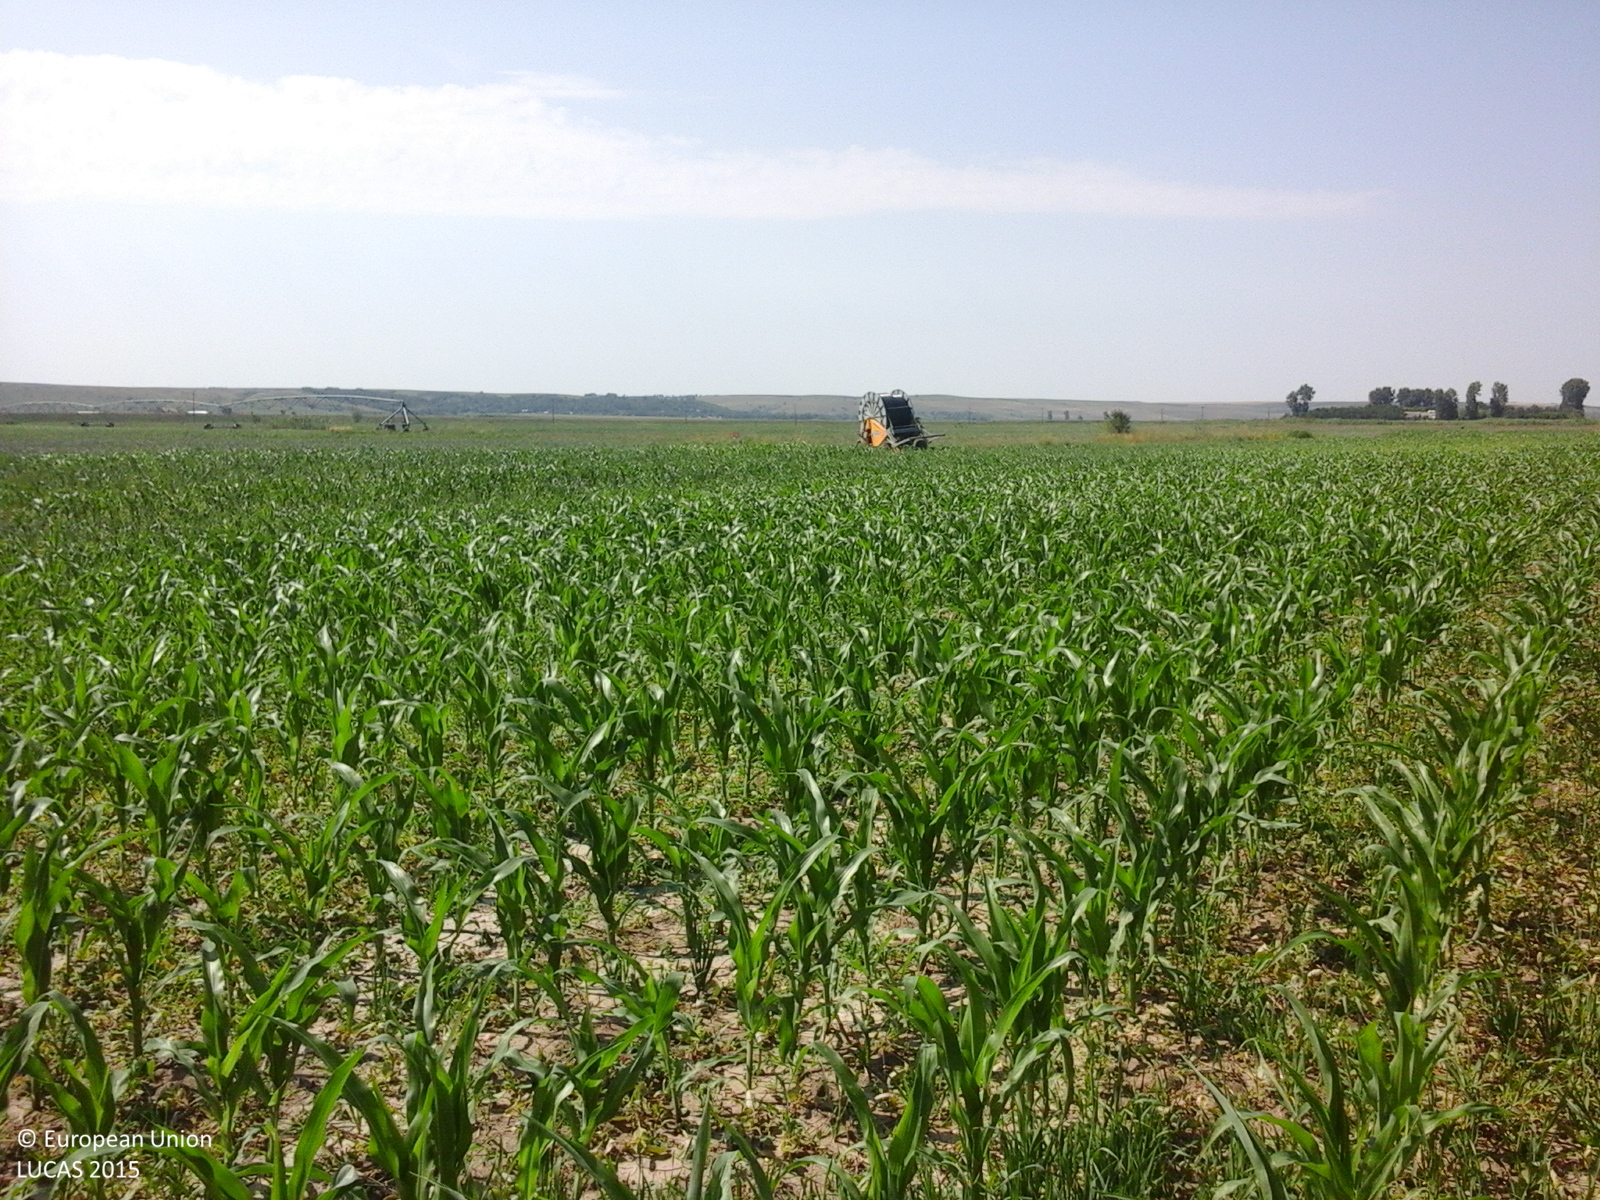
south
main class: Cropland
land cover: Maize
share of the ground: 50 - 75 %
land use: Agriculture (excluding fallow land and kitchen gardens)
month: July
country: RO
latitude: 46.1168
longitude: 27.5652
